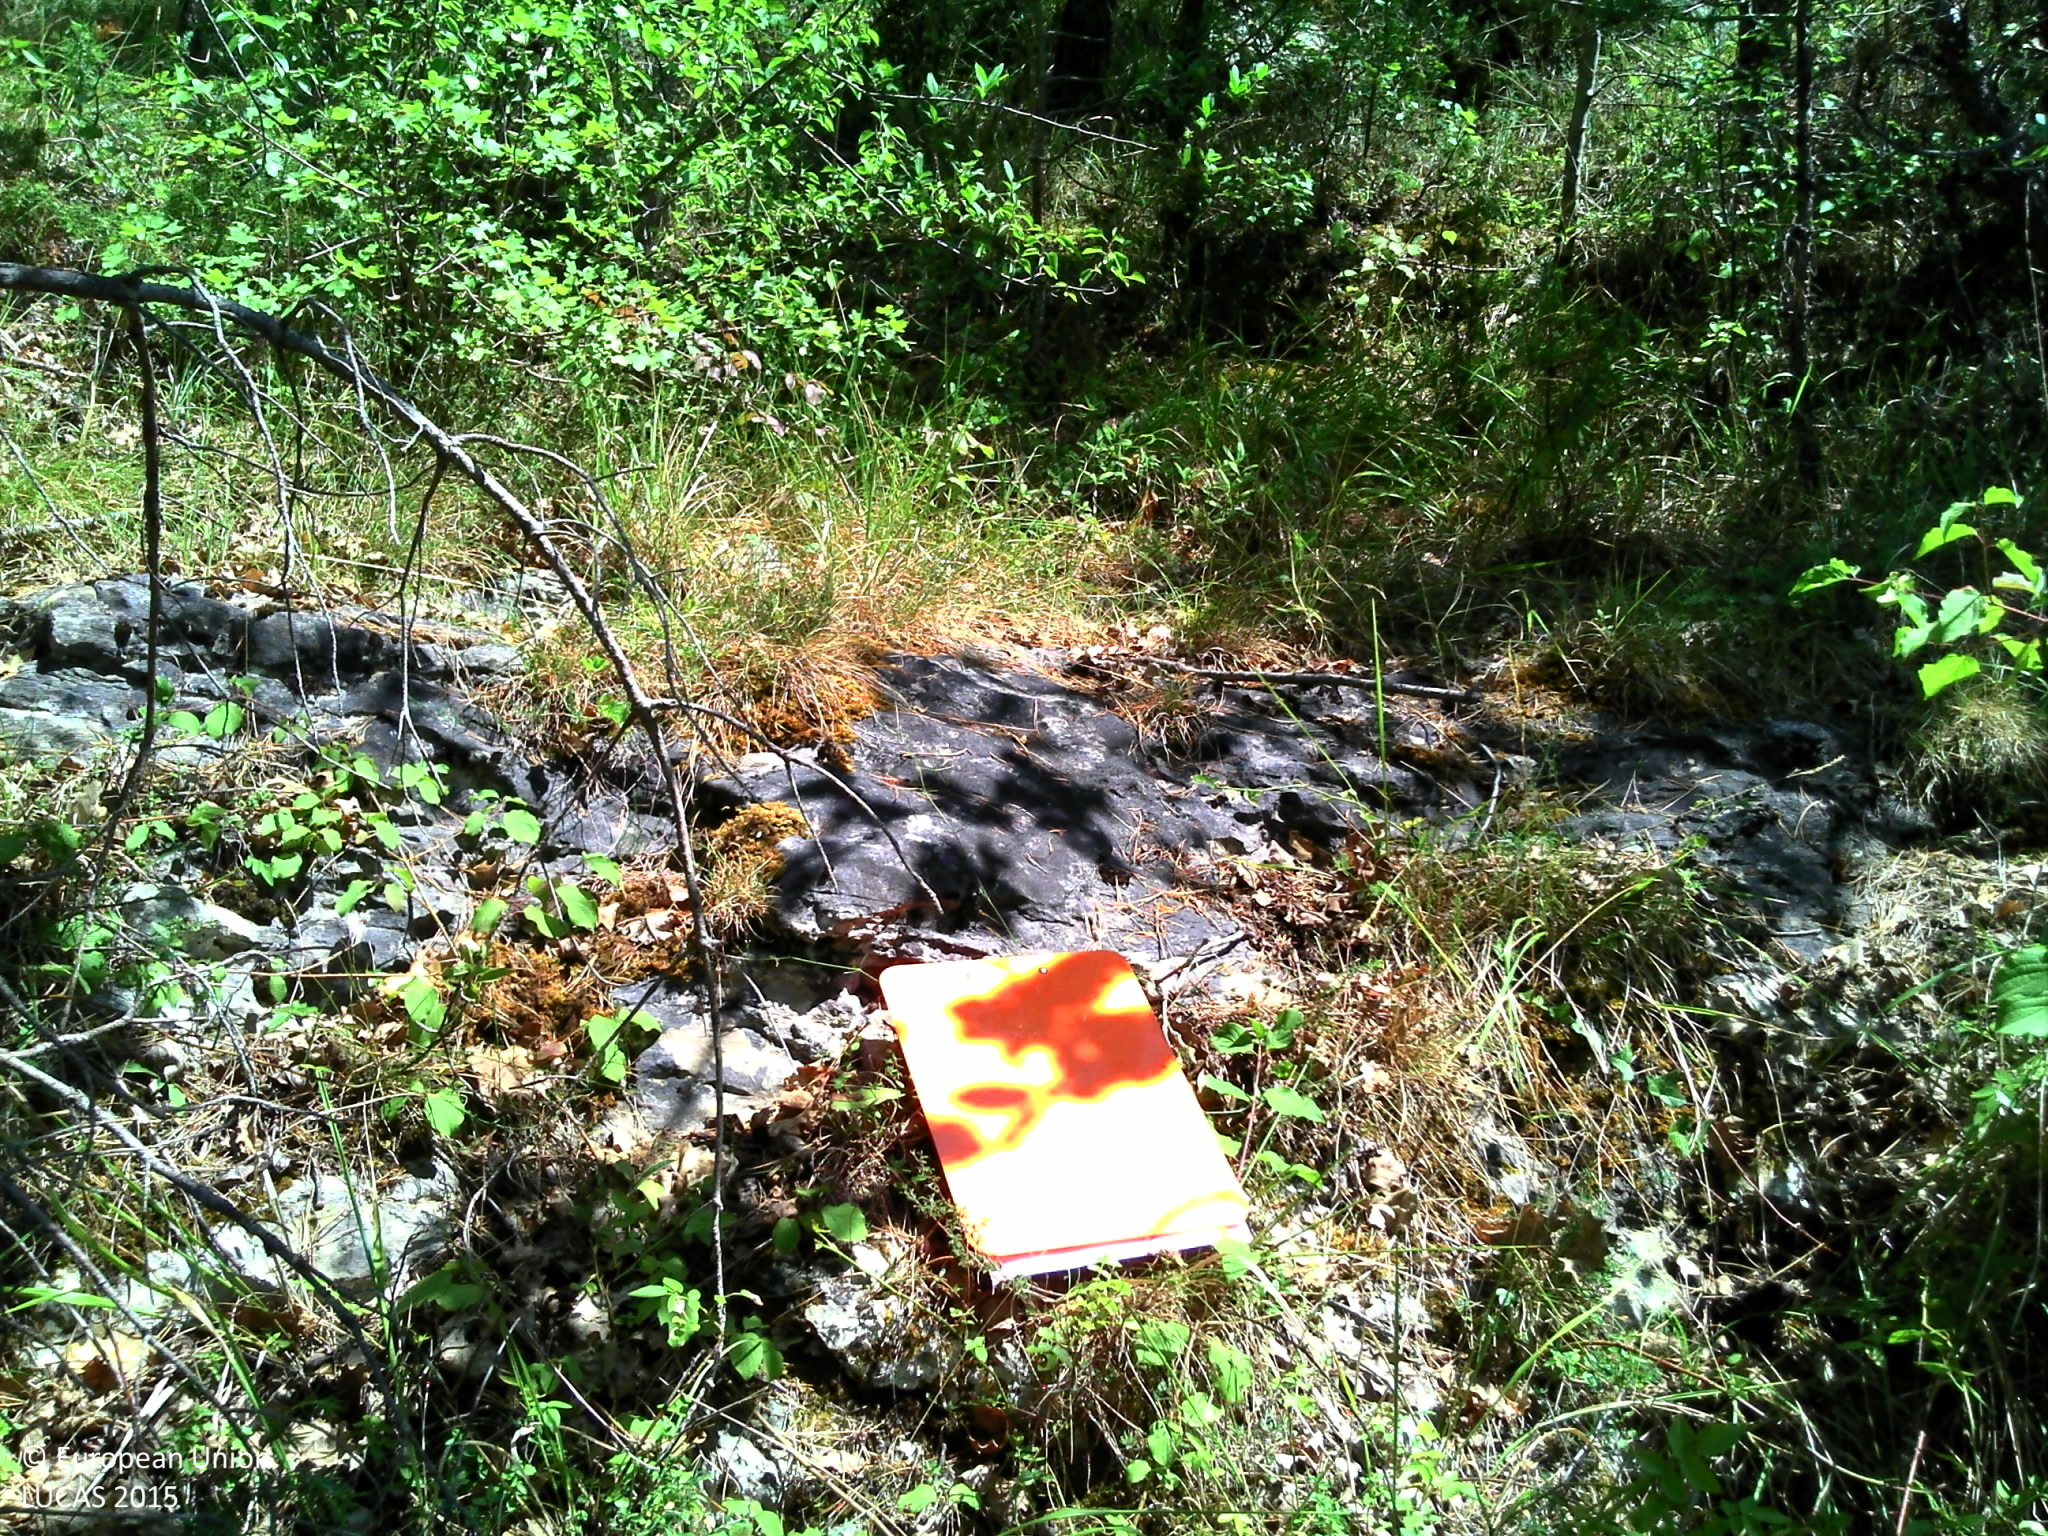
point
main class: Woodland
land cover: Pine dominated mixed woodland
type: thermophilous deciduous forest
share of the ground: 50 - 75 %
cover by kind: coniferous forest trees 40 %, broadleaved forest trees 30 %, shrubs 10 %, herbaceous plants 10 %, lichens and mosses 10 %
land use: Forestry
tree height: > 5 m
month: August
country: FR
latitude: 44.7349
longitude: 1.1684
